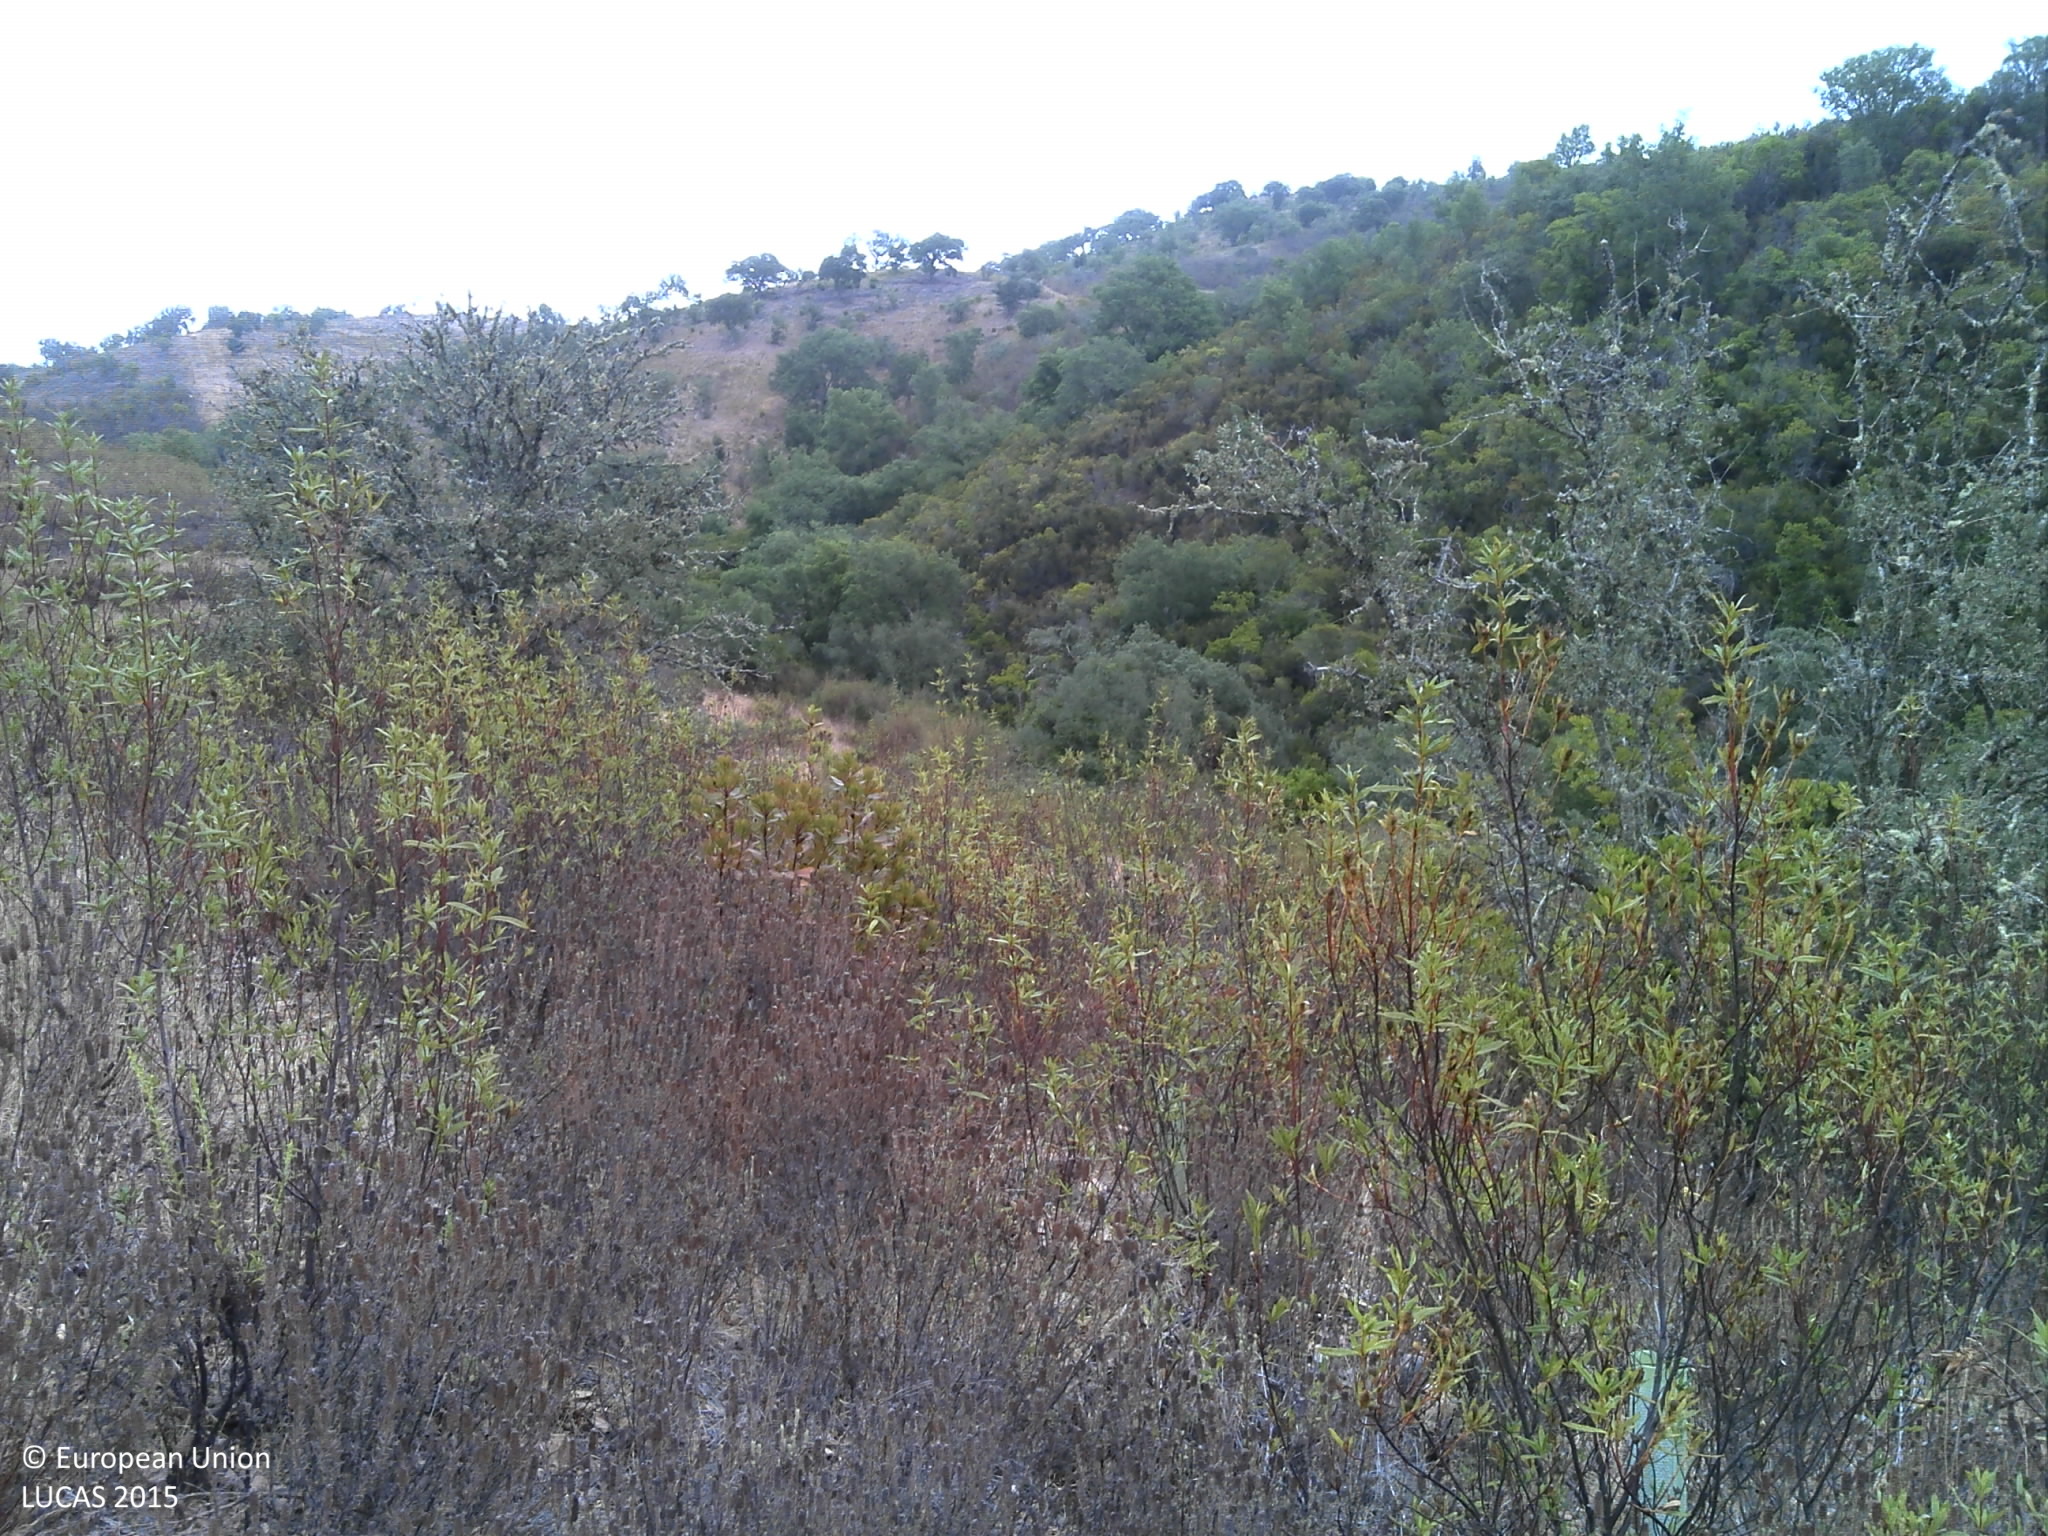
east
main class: Woodland
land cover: Broadleaved woodland
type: broadleaved evergreen forest
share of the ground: 10 - 25 %
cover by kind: herbaceous plants 50 %, unconsolidated bare surface 30 %, broadleaved forest trees 15 %, shrubs 5 %
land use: Forestry
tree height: < 5 m
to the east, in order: Broadleaved woodland; Rivers and streams; Broadleaved woodland; Tracks; Shrubland with sparse tree cover
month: September
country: PT
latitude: 37.4595
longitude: -8.4700
